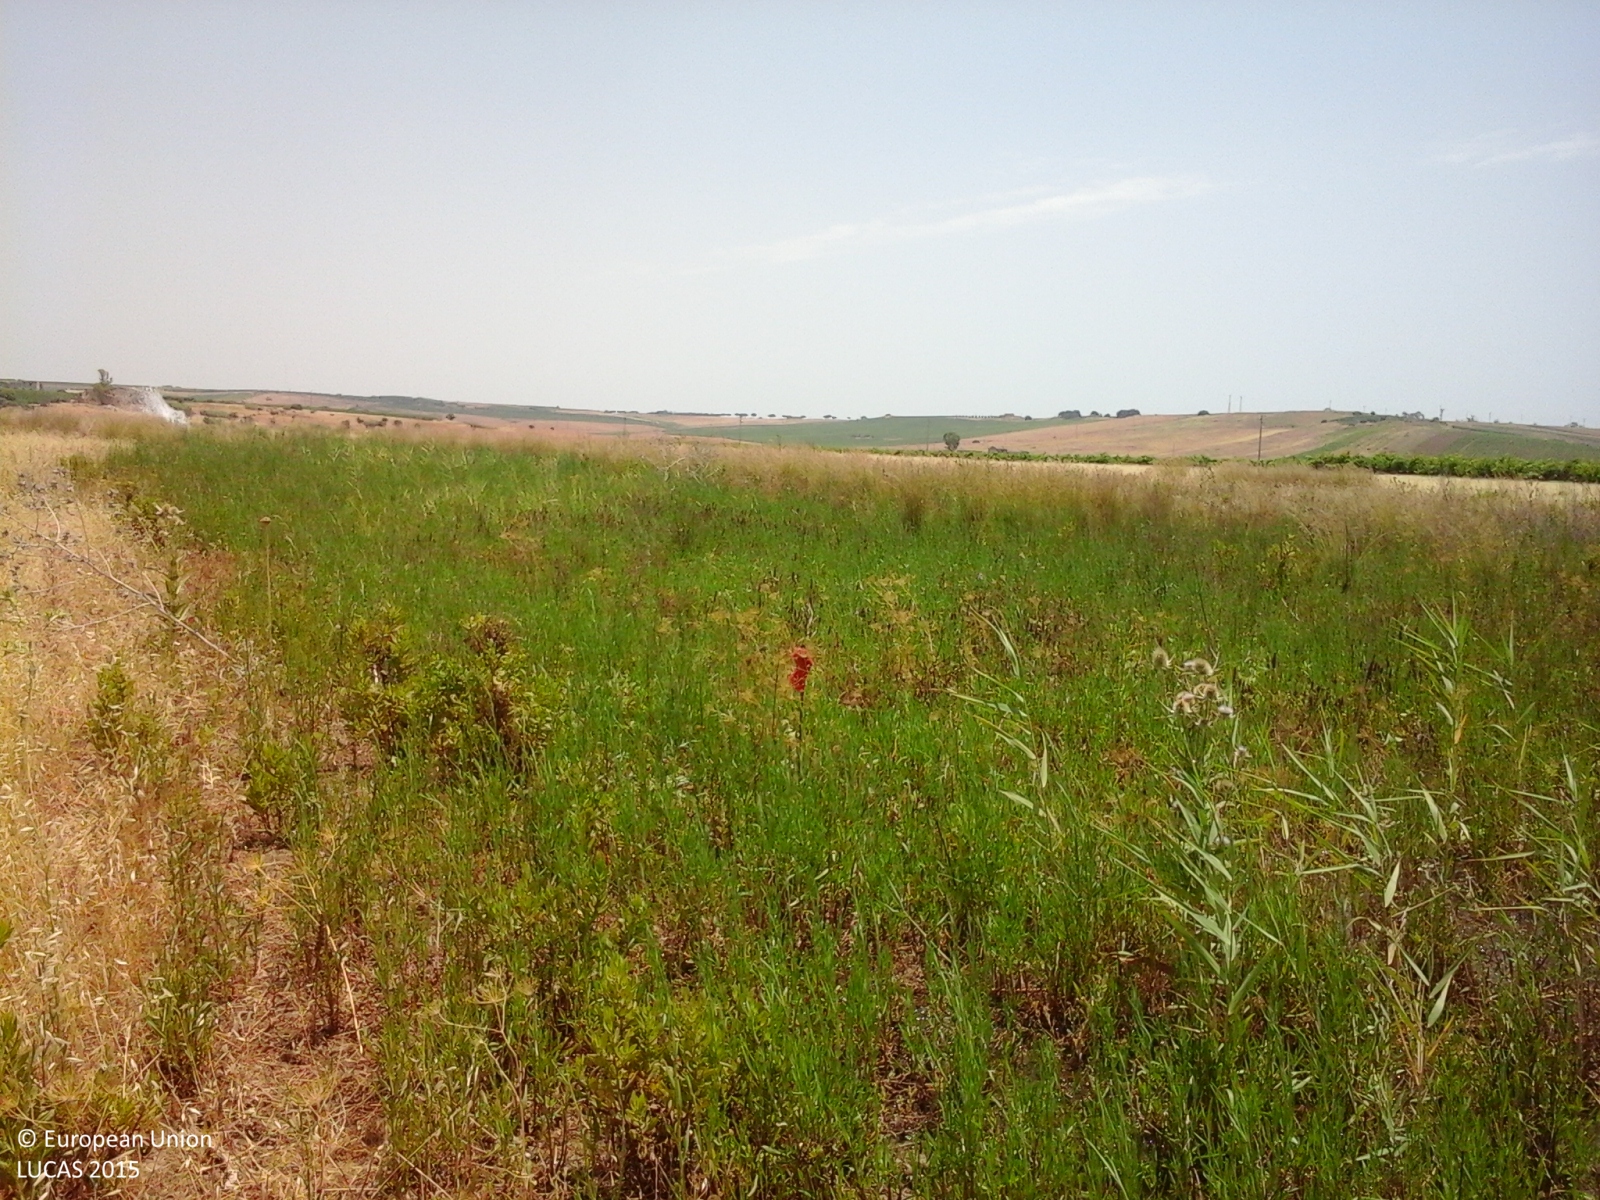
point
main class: Grassland
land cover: Spontaneously vegetated surfaces
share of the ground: > 75 %
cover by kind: herbaceous plants 100 %
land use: Fallow land
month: May
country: IT
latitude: 37.6557
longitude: 12.6661
